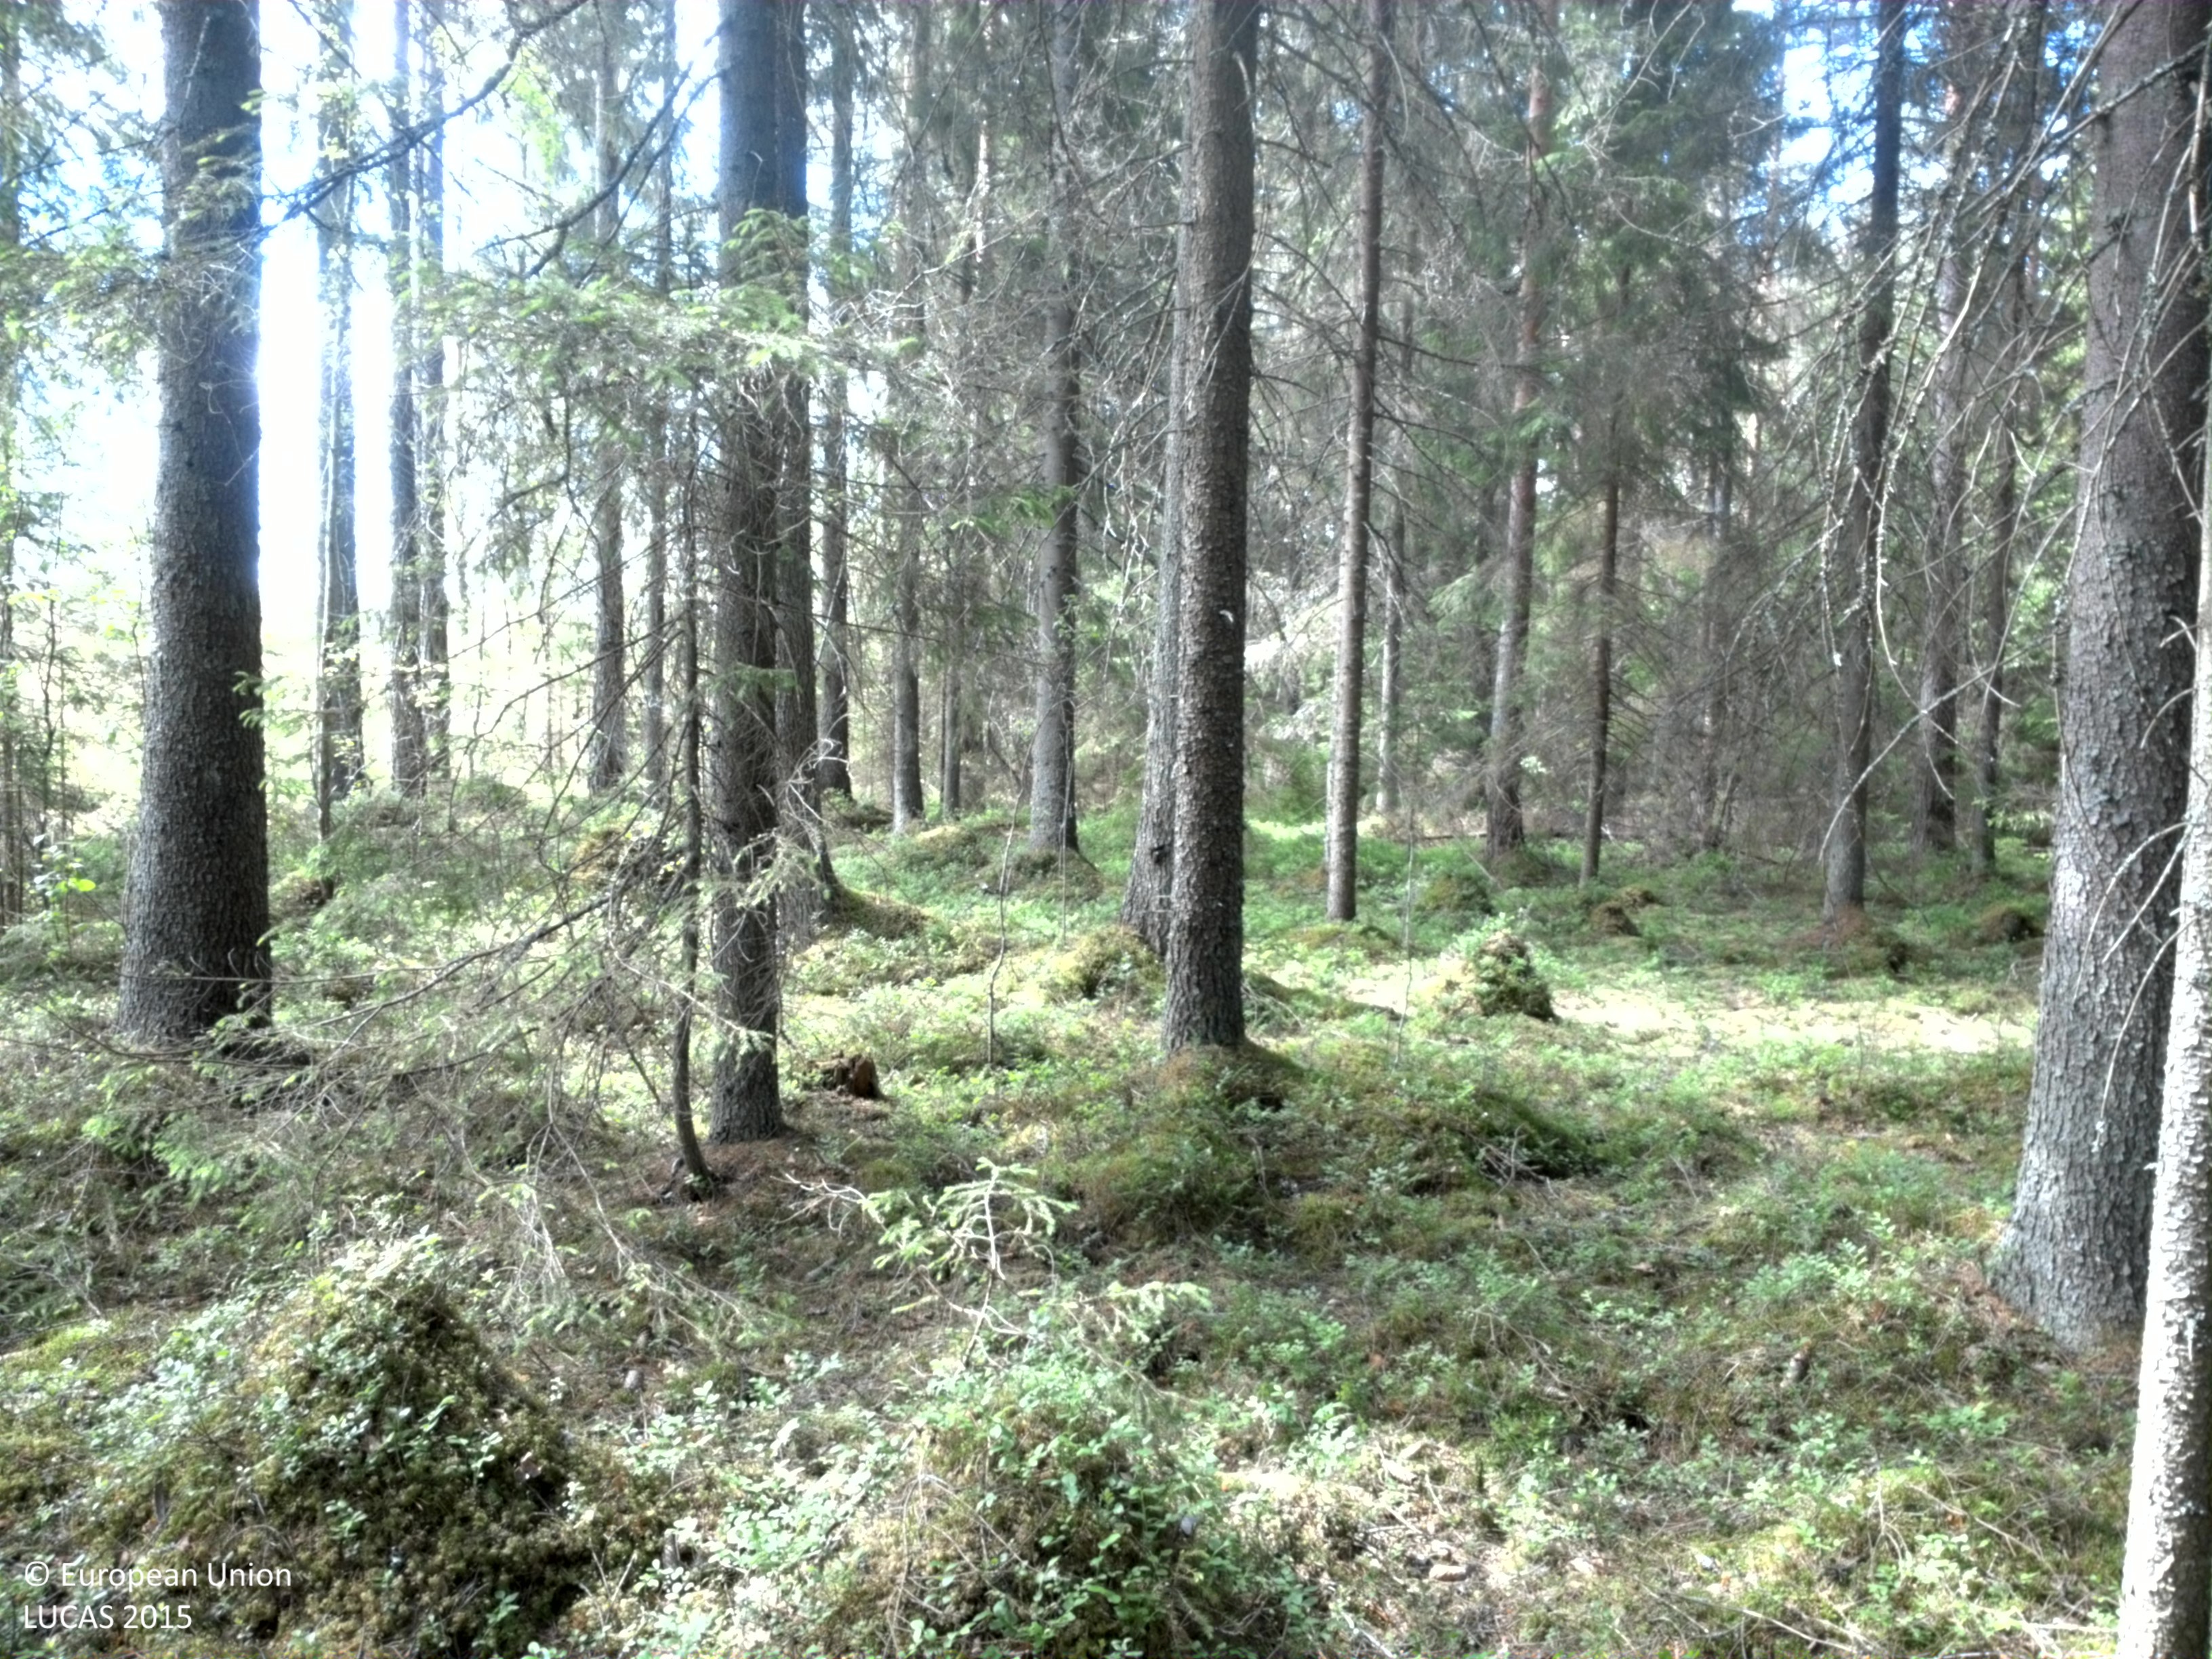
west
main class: Woodland
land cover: Spruce dominated coniferous woodland
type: boreal forest
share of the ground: > 75 %
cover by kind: coniferous forest trees 70 %, herbaceous plants 20 %, broadleaved forest trees 10 %
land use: Forestry
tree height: > 5 m
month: July
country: SE
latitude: 60.0228
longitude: 17.0431
